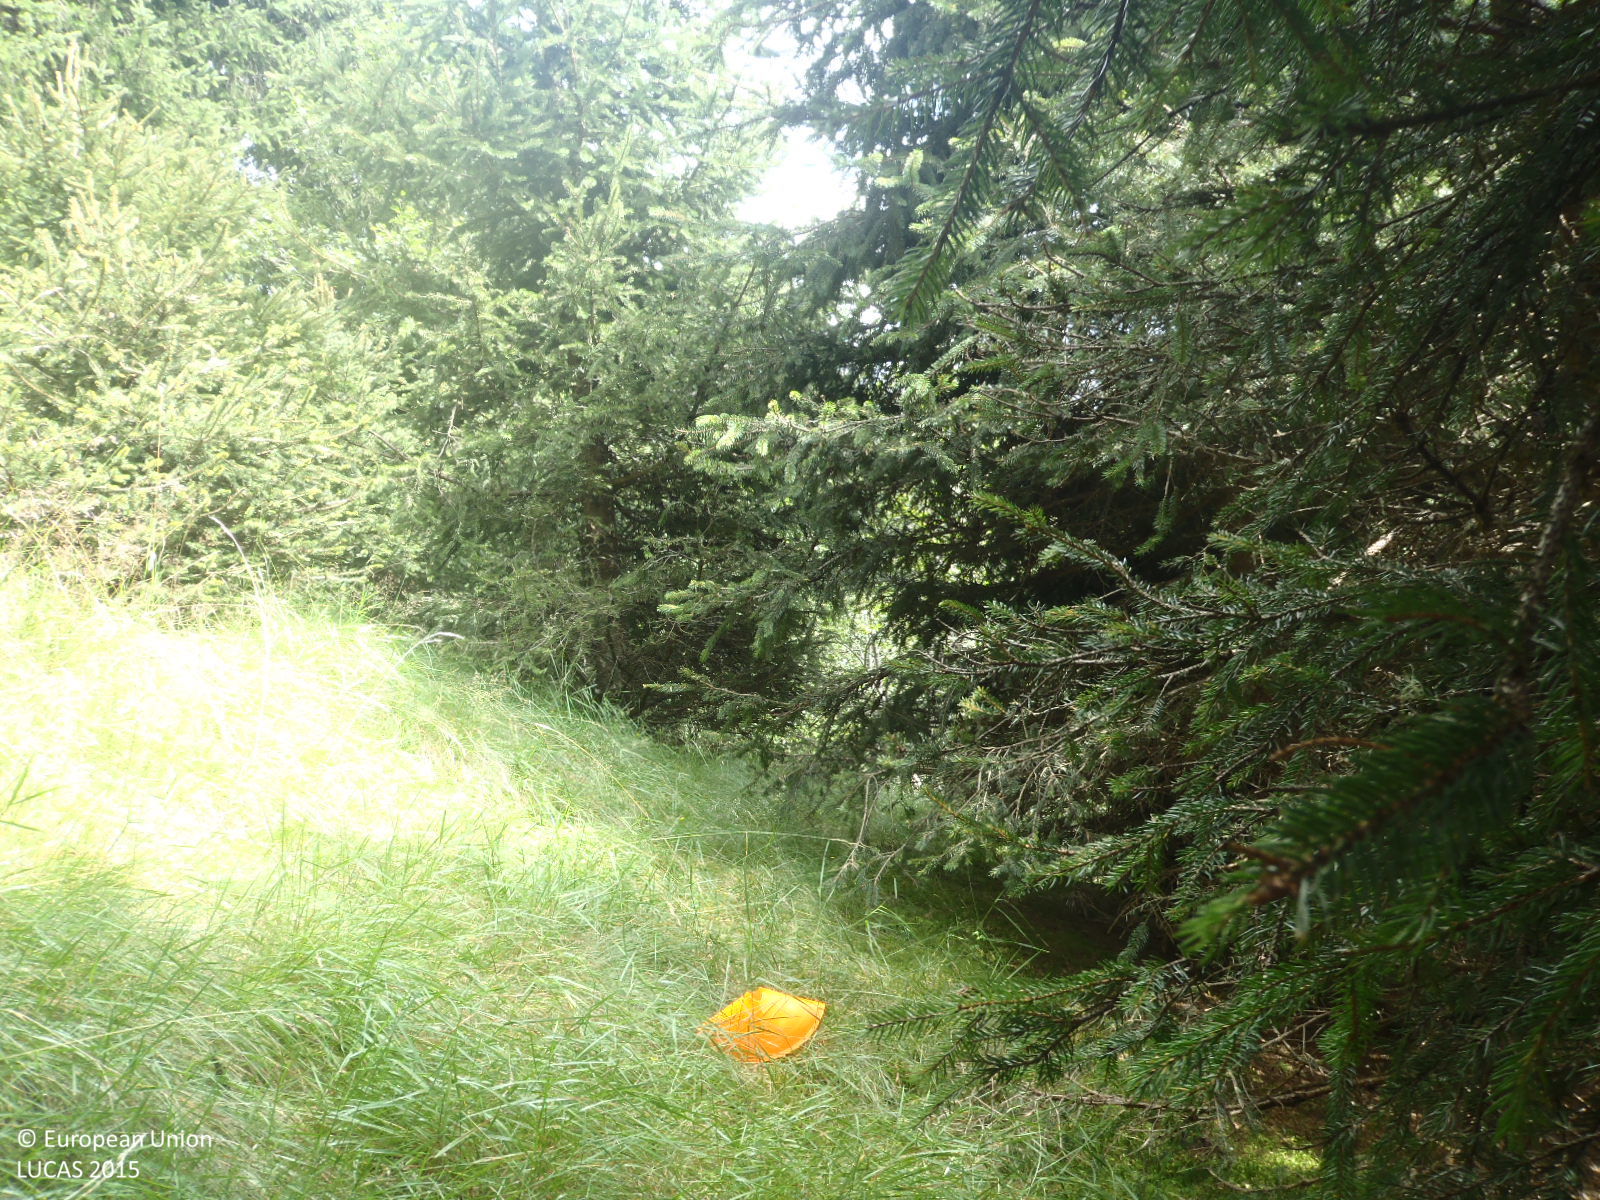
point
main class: Woodland
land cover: Spruce dominated coniferous woodland
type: alpine coniferous forest
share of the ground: > 75 %
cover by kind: coniferous forest trees 90 %, herbaceous plants 10 %
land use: Forestry
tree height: > 5 m
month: August
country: AT
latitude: 46.9200
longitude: 12.3484
